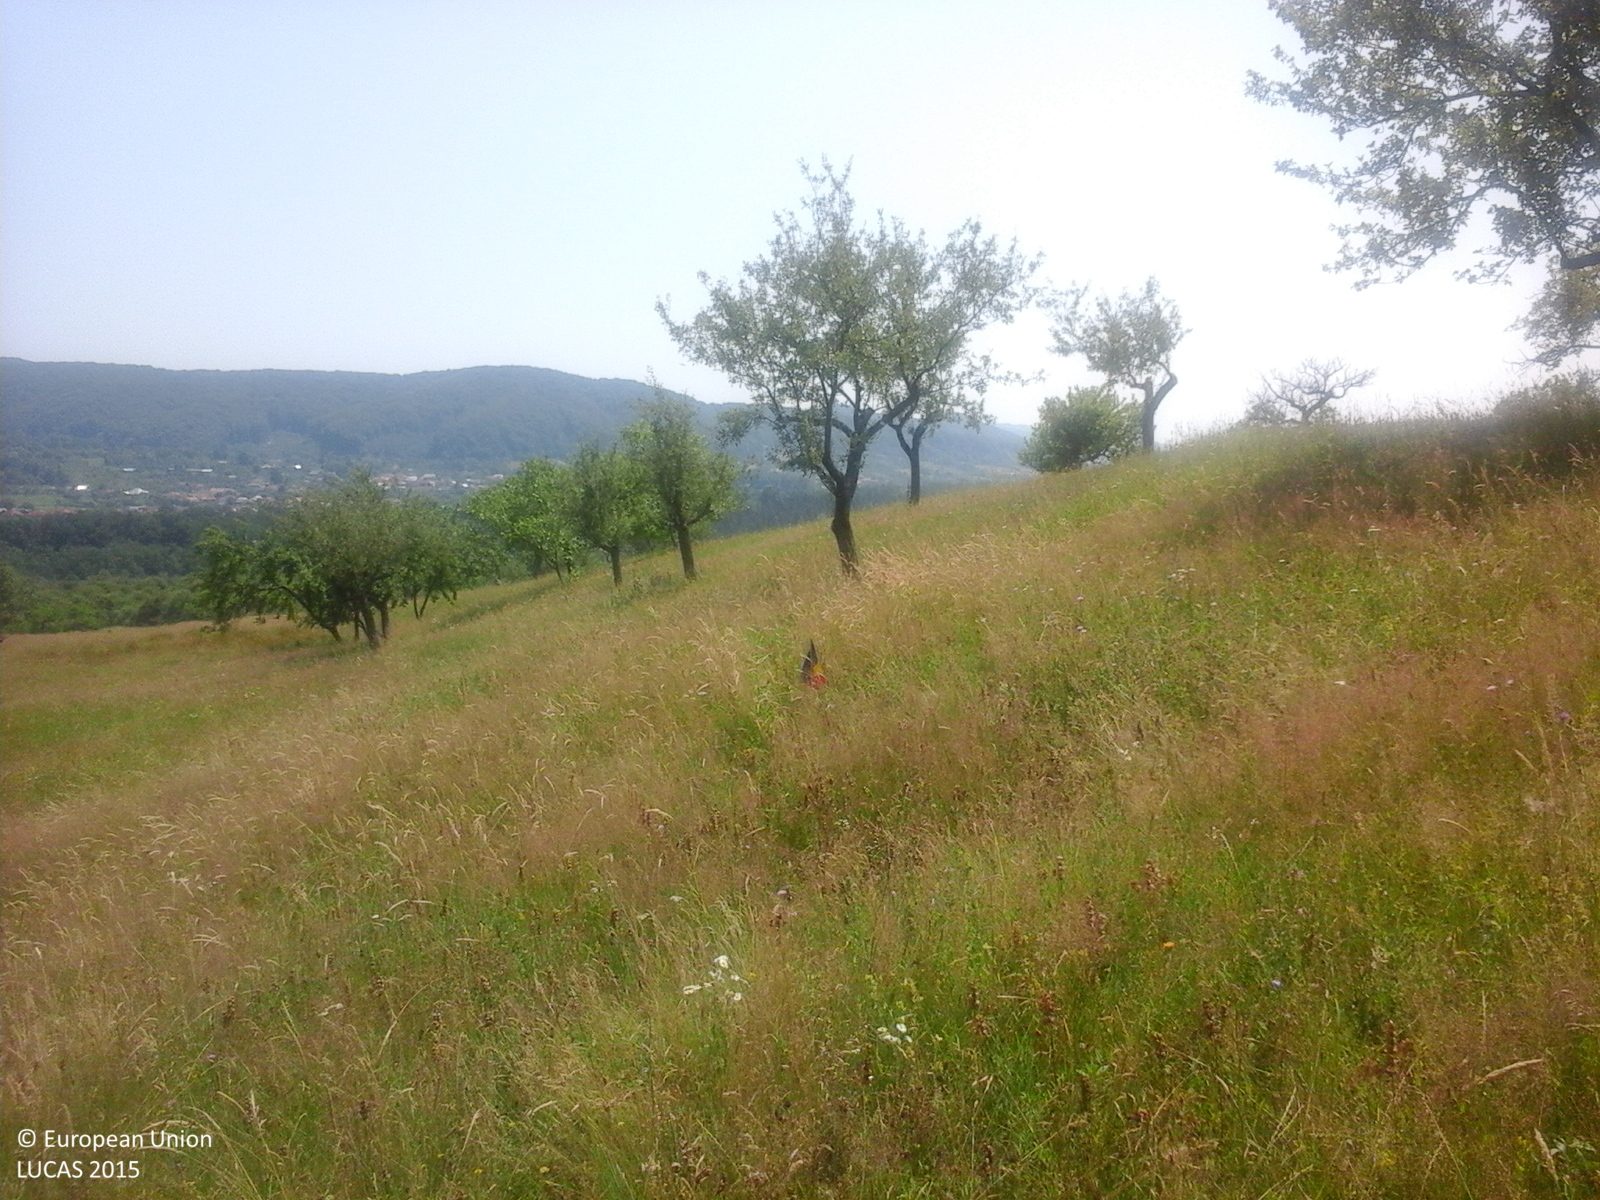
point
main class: Cropland
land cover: Apple fruit
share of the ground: 50 - 75 %
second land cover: Grassland without tree/shrub cover
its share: > 75 %
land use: Agriculture (excluding fallow land and kitchen gardens)
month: July
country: RO
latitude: 45.2062
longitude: 24.9179
